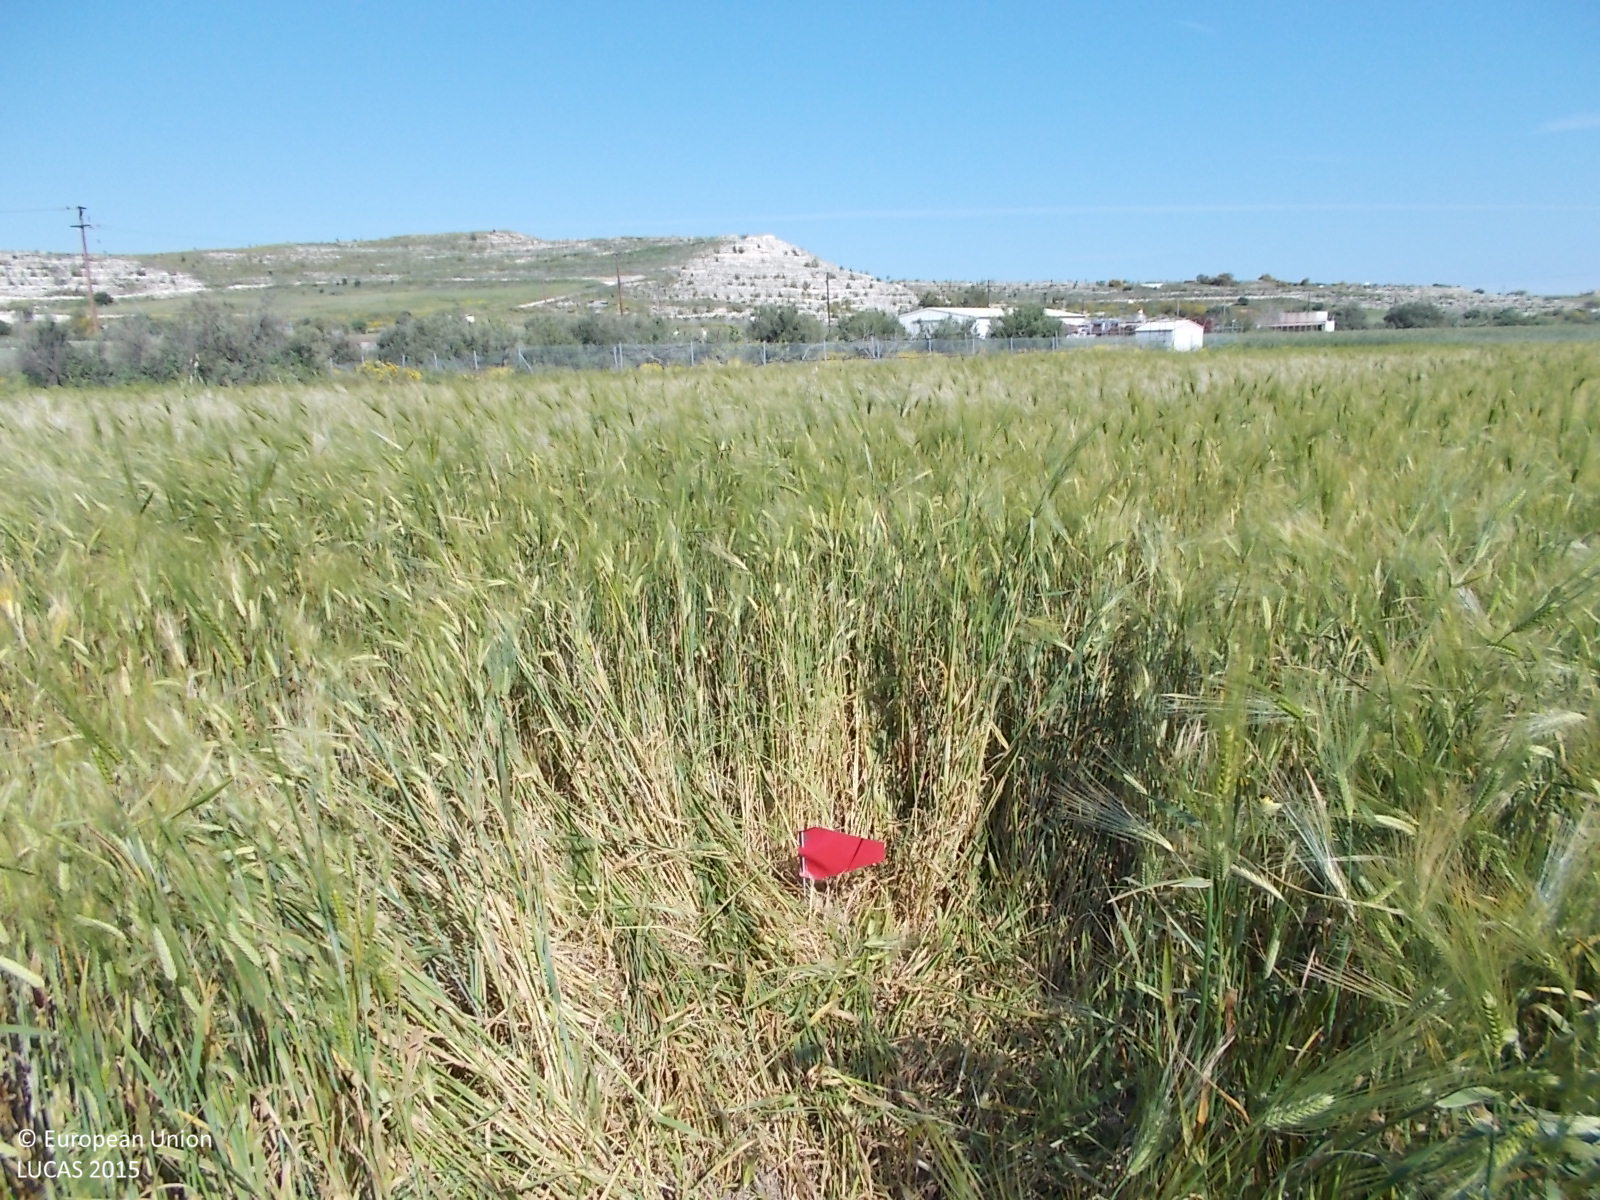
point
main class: Cropland
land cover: Barley
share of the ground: > 75 %
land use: Agriculture (excluding fallow land and kitchen gardens)
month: April
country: CY
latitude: 34.9688
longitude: 33.5571
